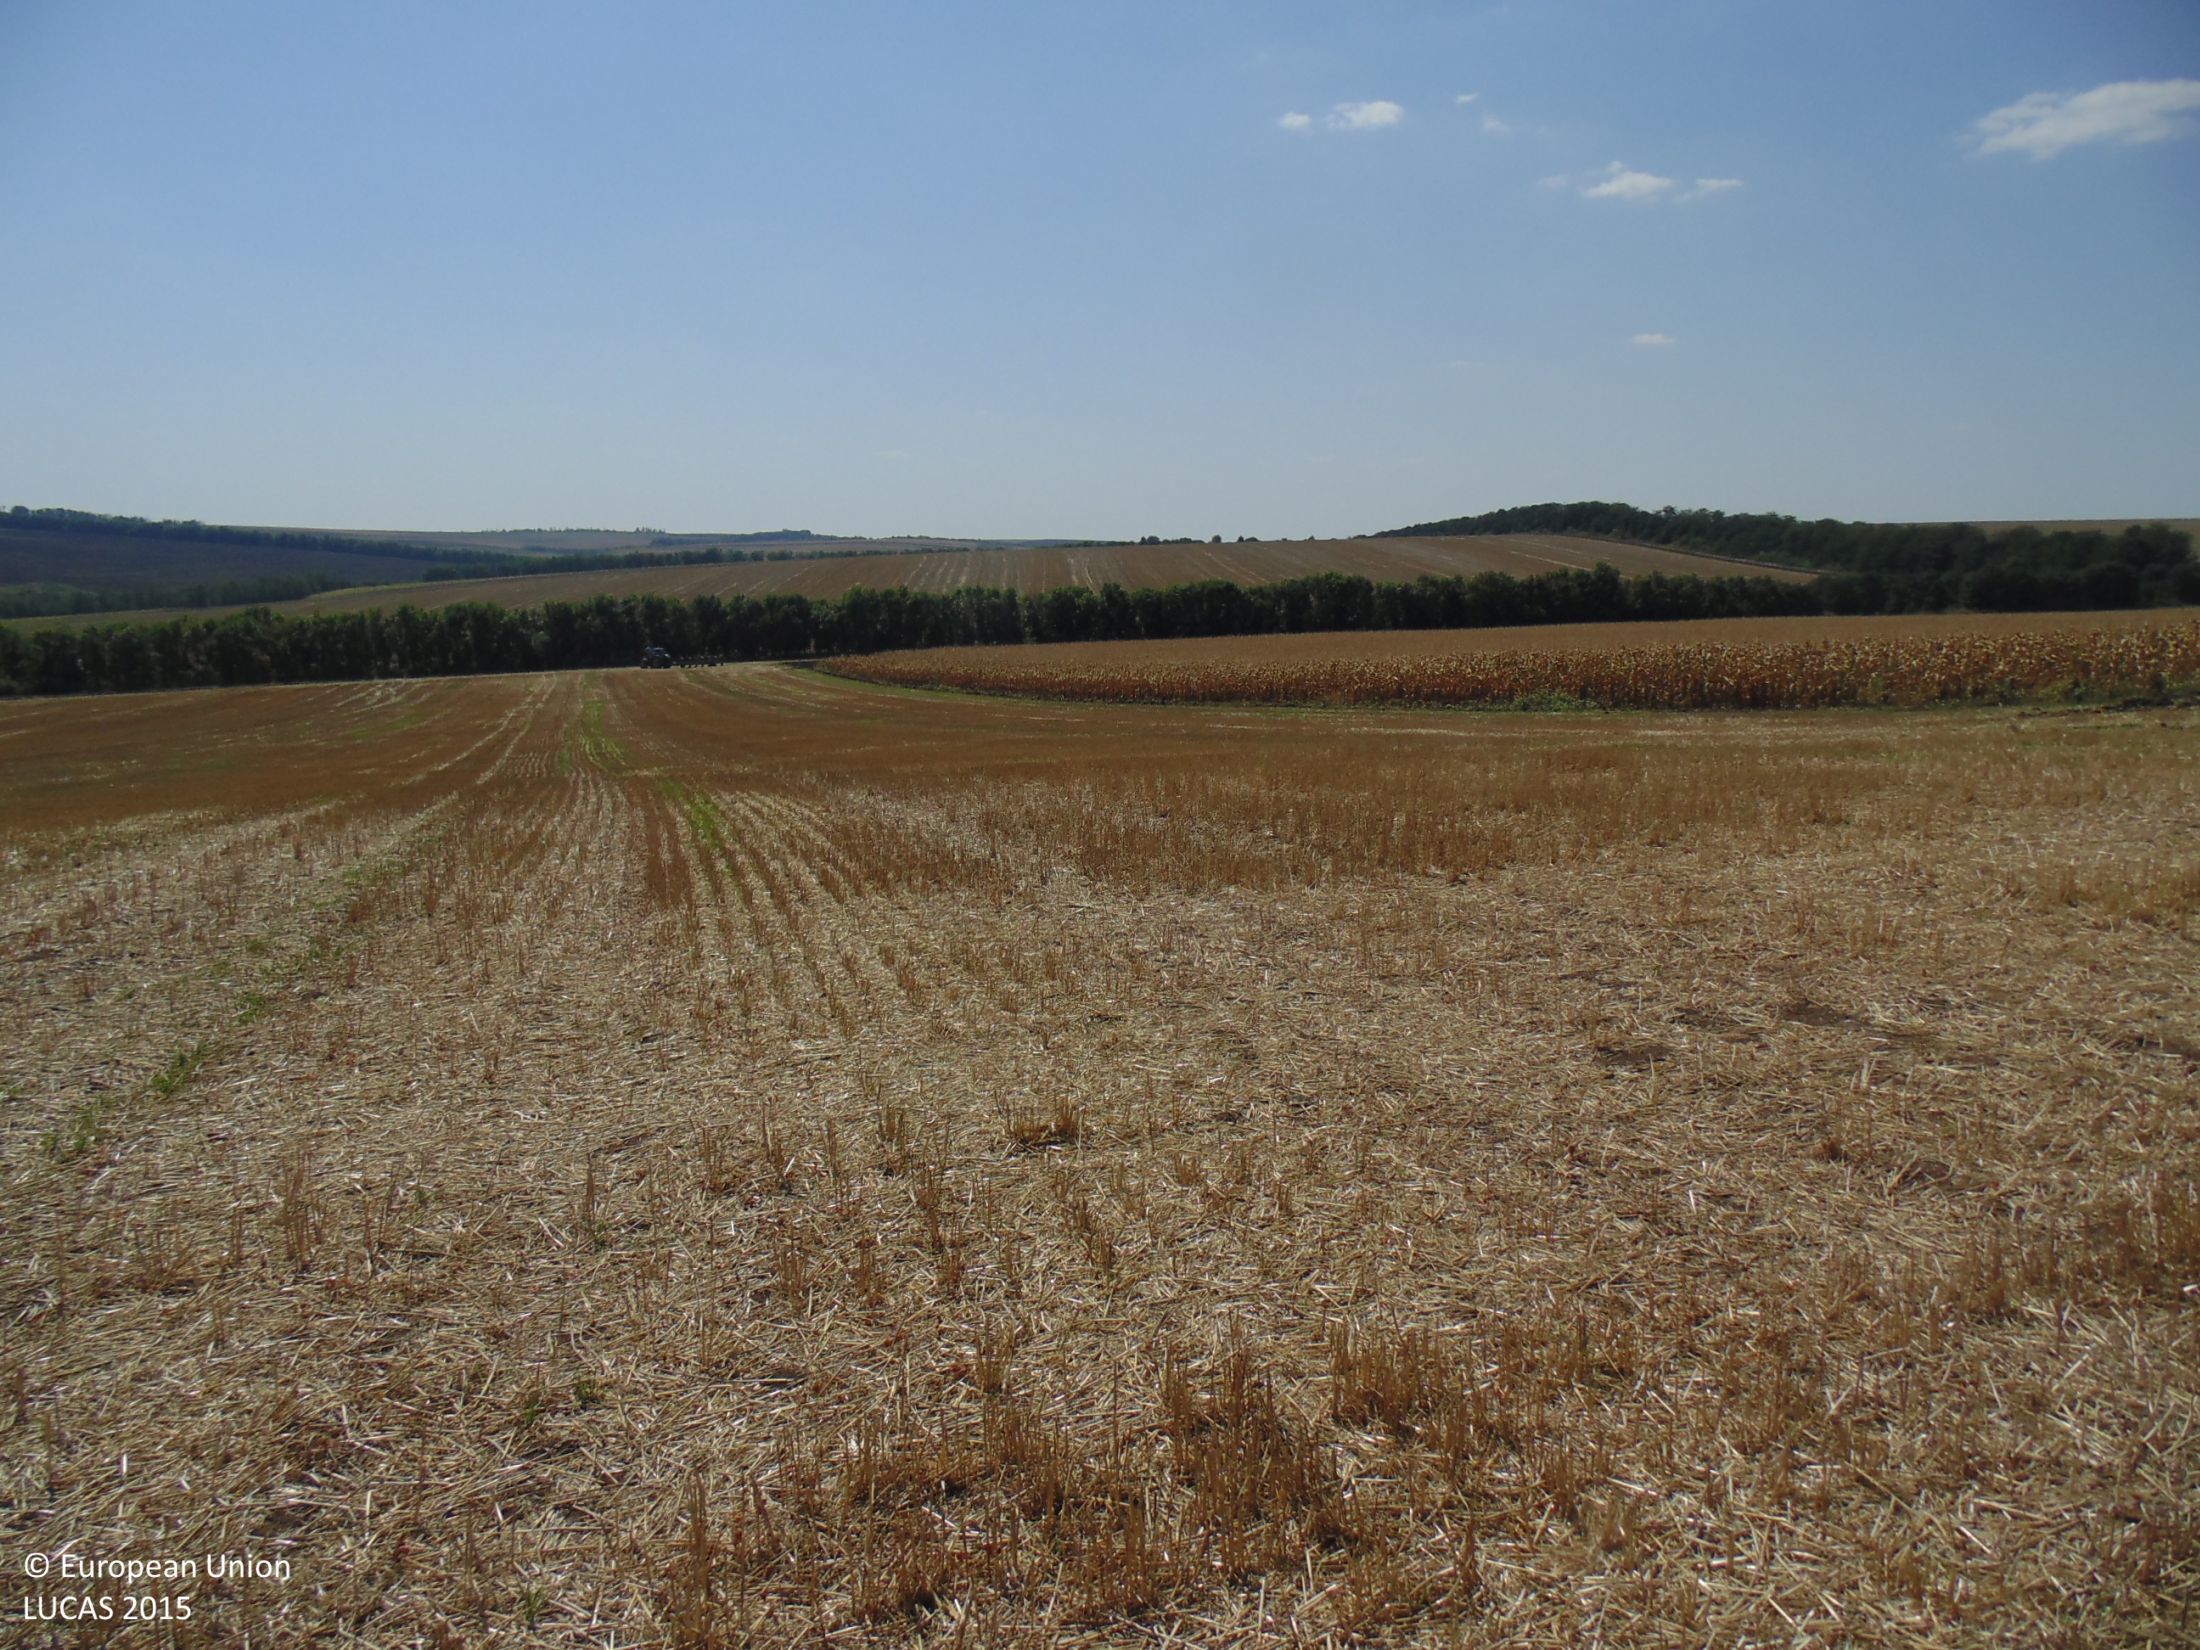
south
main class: Cropland
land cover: Common wheat
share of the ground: 25 - 50 %
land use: Agriculture (excluding fallow land and kitchen gardens)
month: August
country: BG
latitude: 43.6672
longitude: 27.4572
